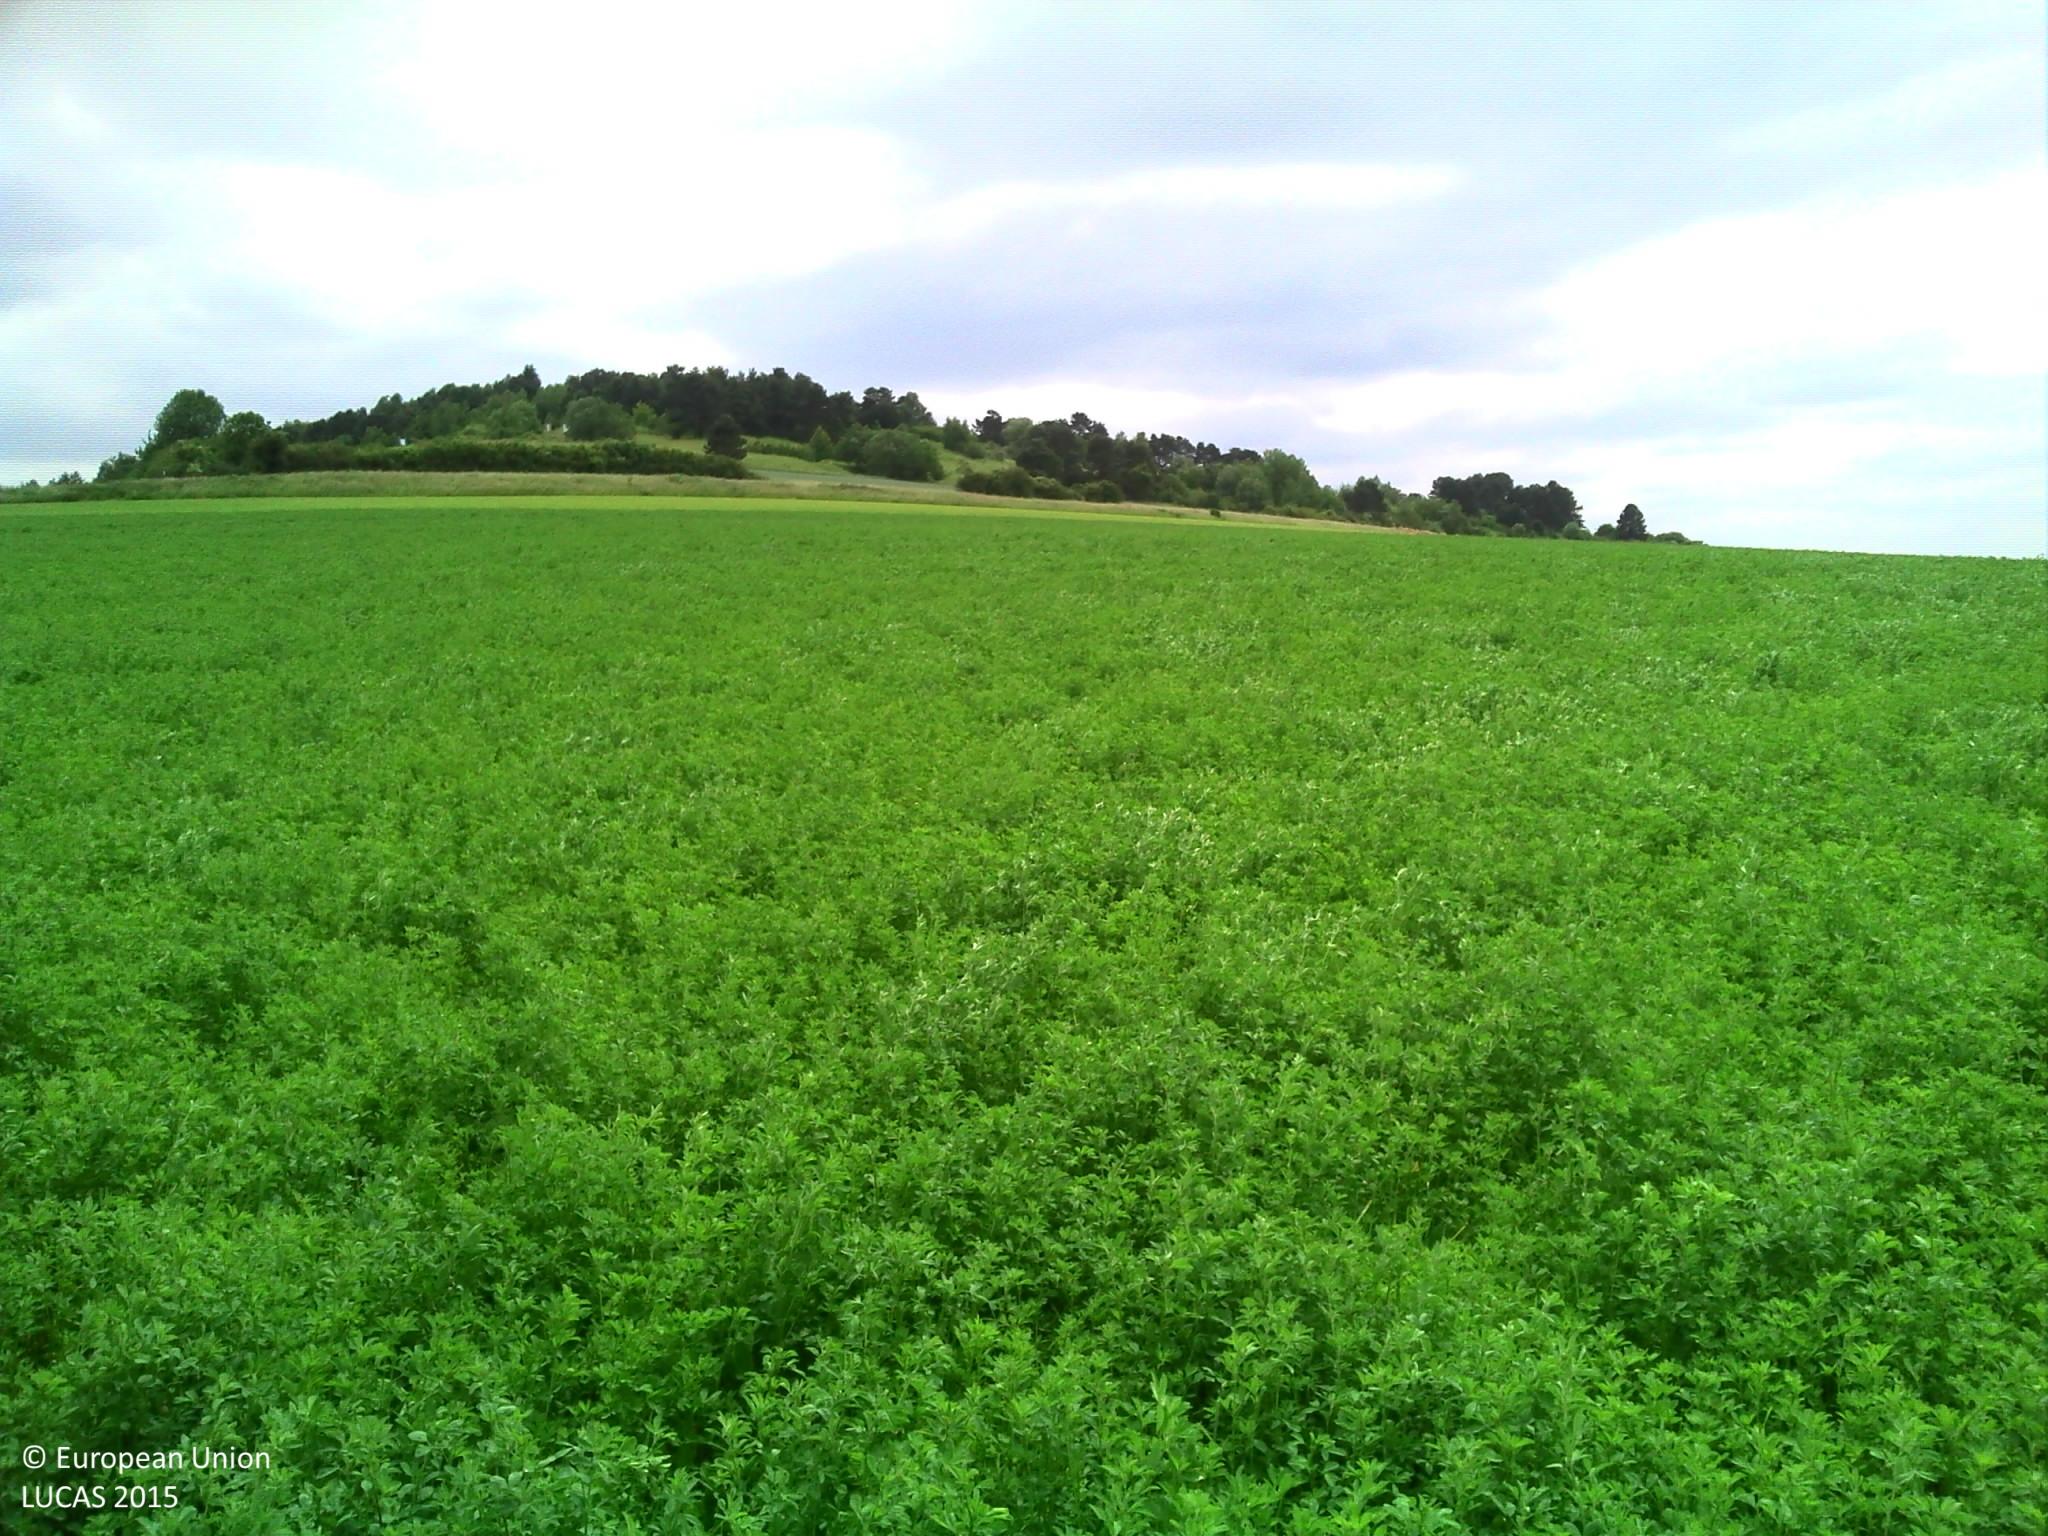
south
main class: Cropland
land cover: Lucerne
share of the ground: > 75 %
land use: Agriculture (excluding fallow land and kitchen gardens)
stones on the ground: 25 - 50 %
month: June
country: FR
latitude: 48.8434
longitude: 6.2255
